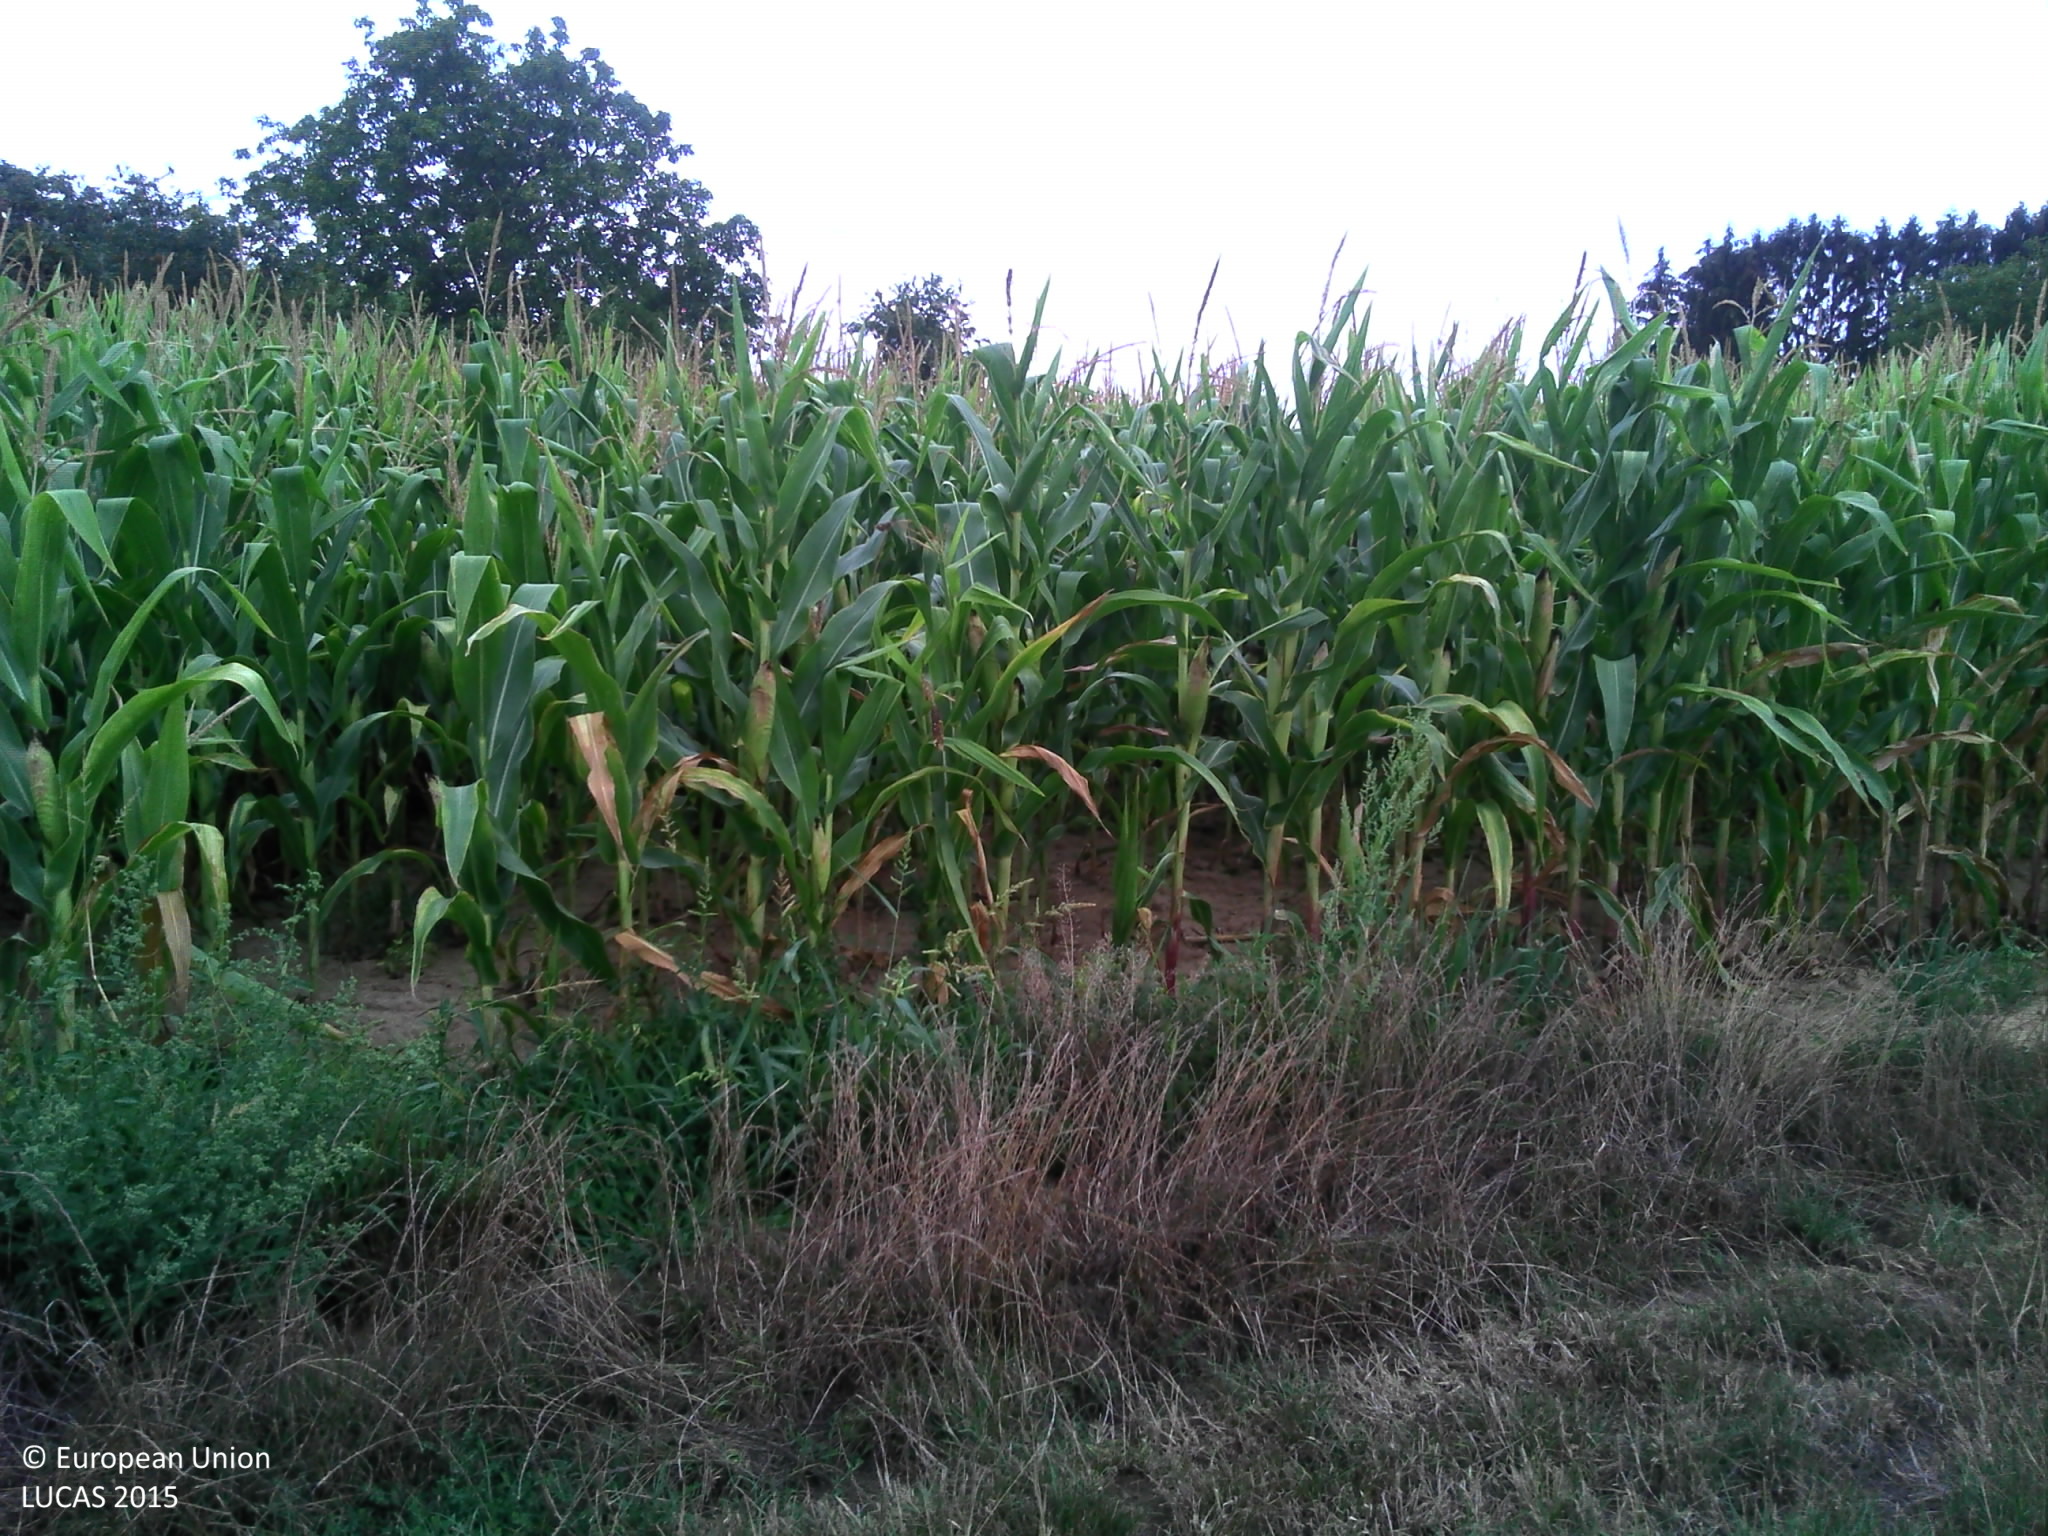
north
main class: Grassland
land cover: Grassland without tree/shrub cover
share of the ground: > 75 %
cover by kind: herbaceous plants 100 %
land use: Agriculture (excluding fallow land and kitchen gardens)
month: August
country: FR
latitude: 48.7402
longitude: 7.7299
